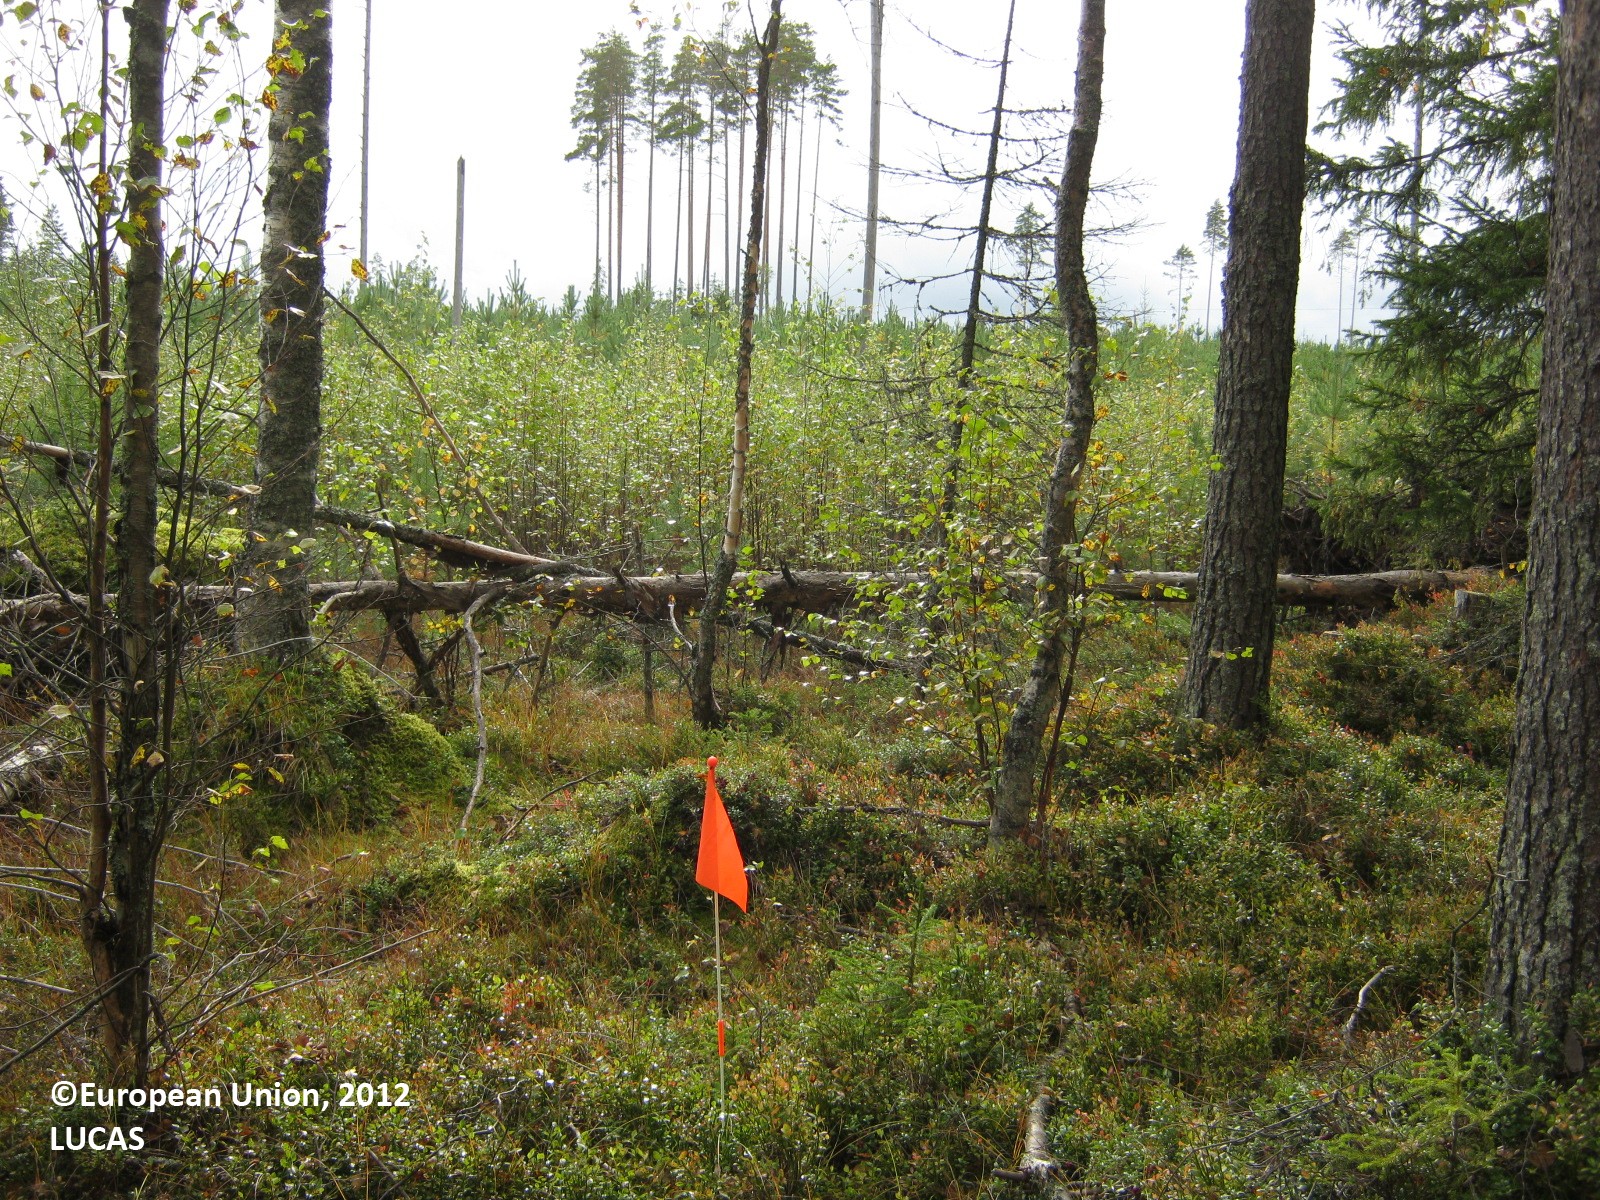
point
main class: Woodland
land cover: Other mixed woodland
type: boreal forest
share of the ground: > 75 %
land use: Forestry
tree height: > 5 m
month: September
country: FI
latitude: 60.8416
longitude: 27.5734
